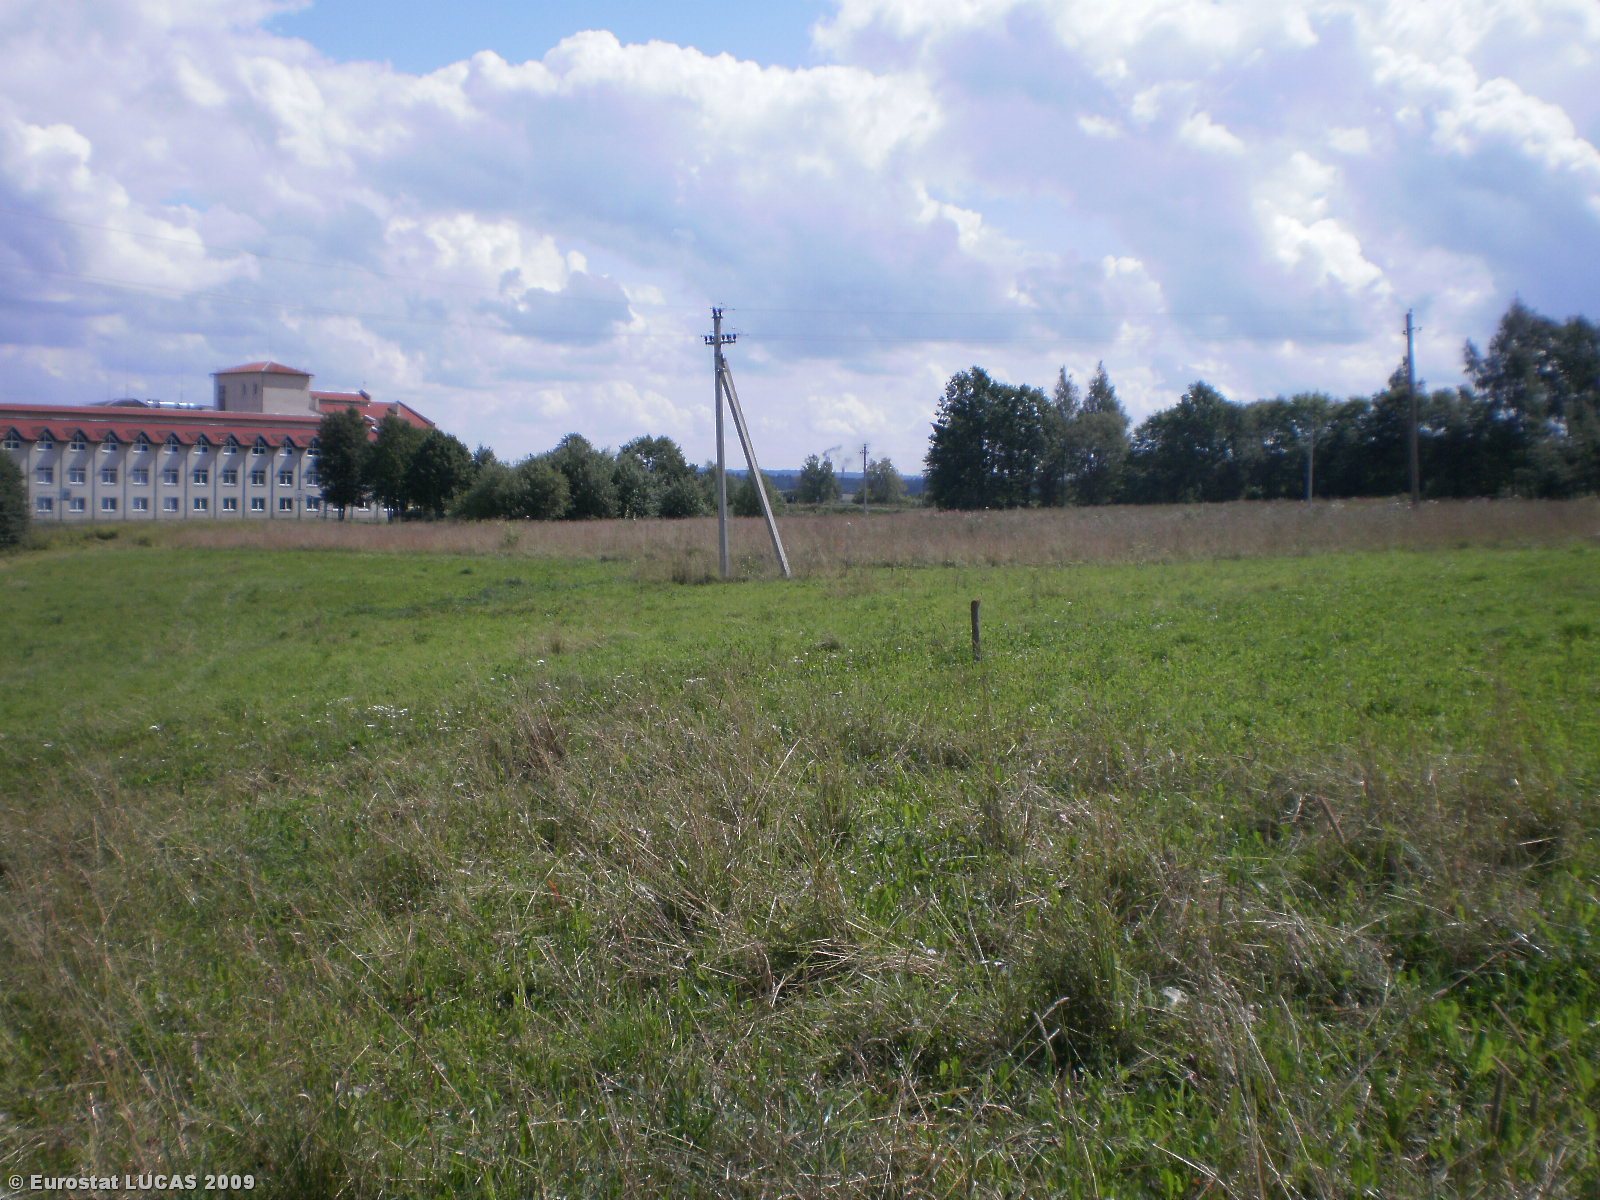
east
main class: Grassland
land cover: Grassland without tree/shrub cover
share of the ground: > 75 %
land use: Agriculture (excluding fallow land and kitchen gardens)
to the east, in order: Grassland without tree/shrub cover; Tracks; Grassland without tree/shrub cover; Spontaneously vegetated surfaces; Fences; Artificial constructions in urban areas
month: July
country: LT
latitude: 55.9632
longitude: 25.7152
